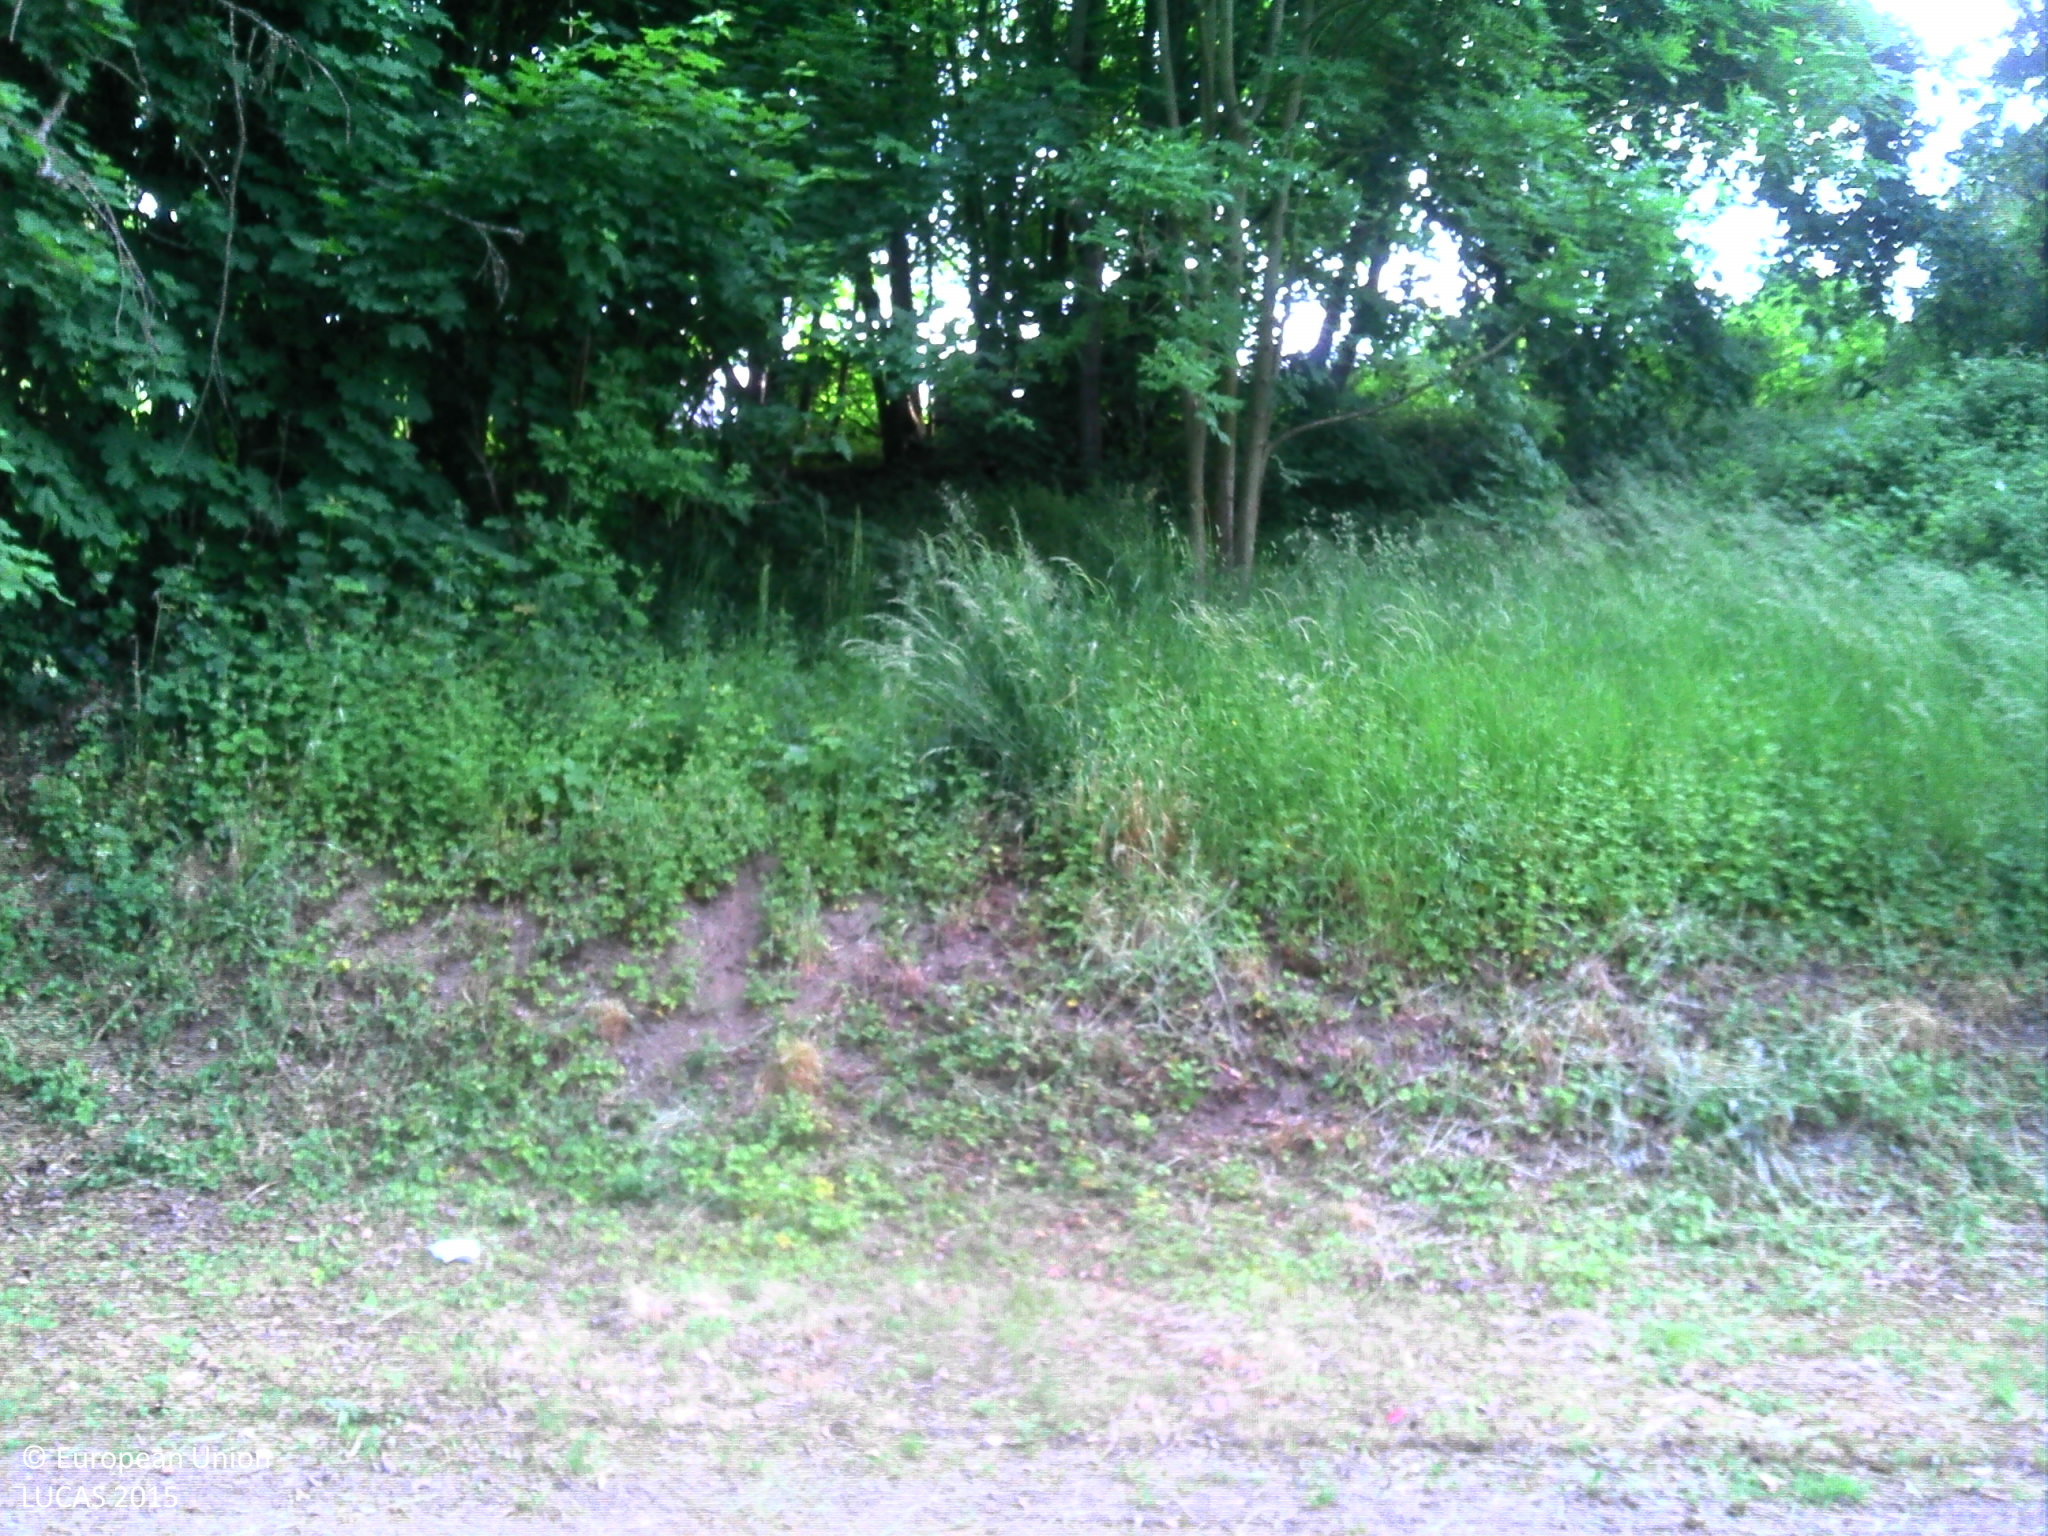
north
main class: Grassland
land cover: Spontaneously vegetated surfaces
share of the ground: > 75 %
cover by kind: herbaceous plants 80 %, unconsolidated bare surface 20 %
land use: Semi-natural and natural areas not in use
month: May
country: BE
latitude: 50.4479
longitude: 4.8848
